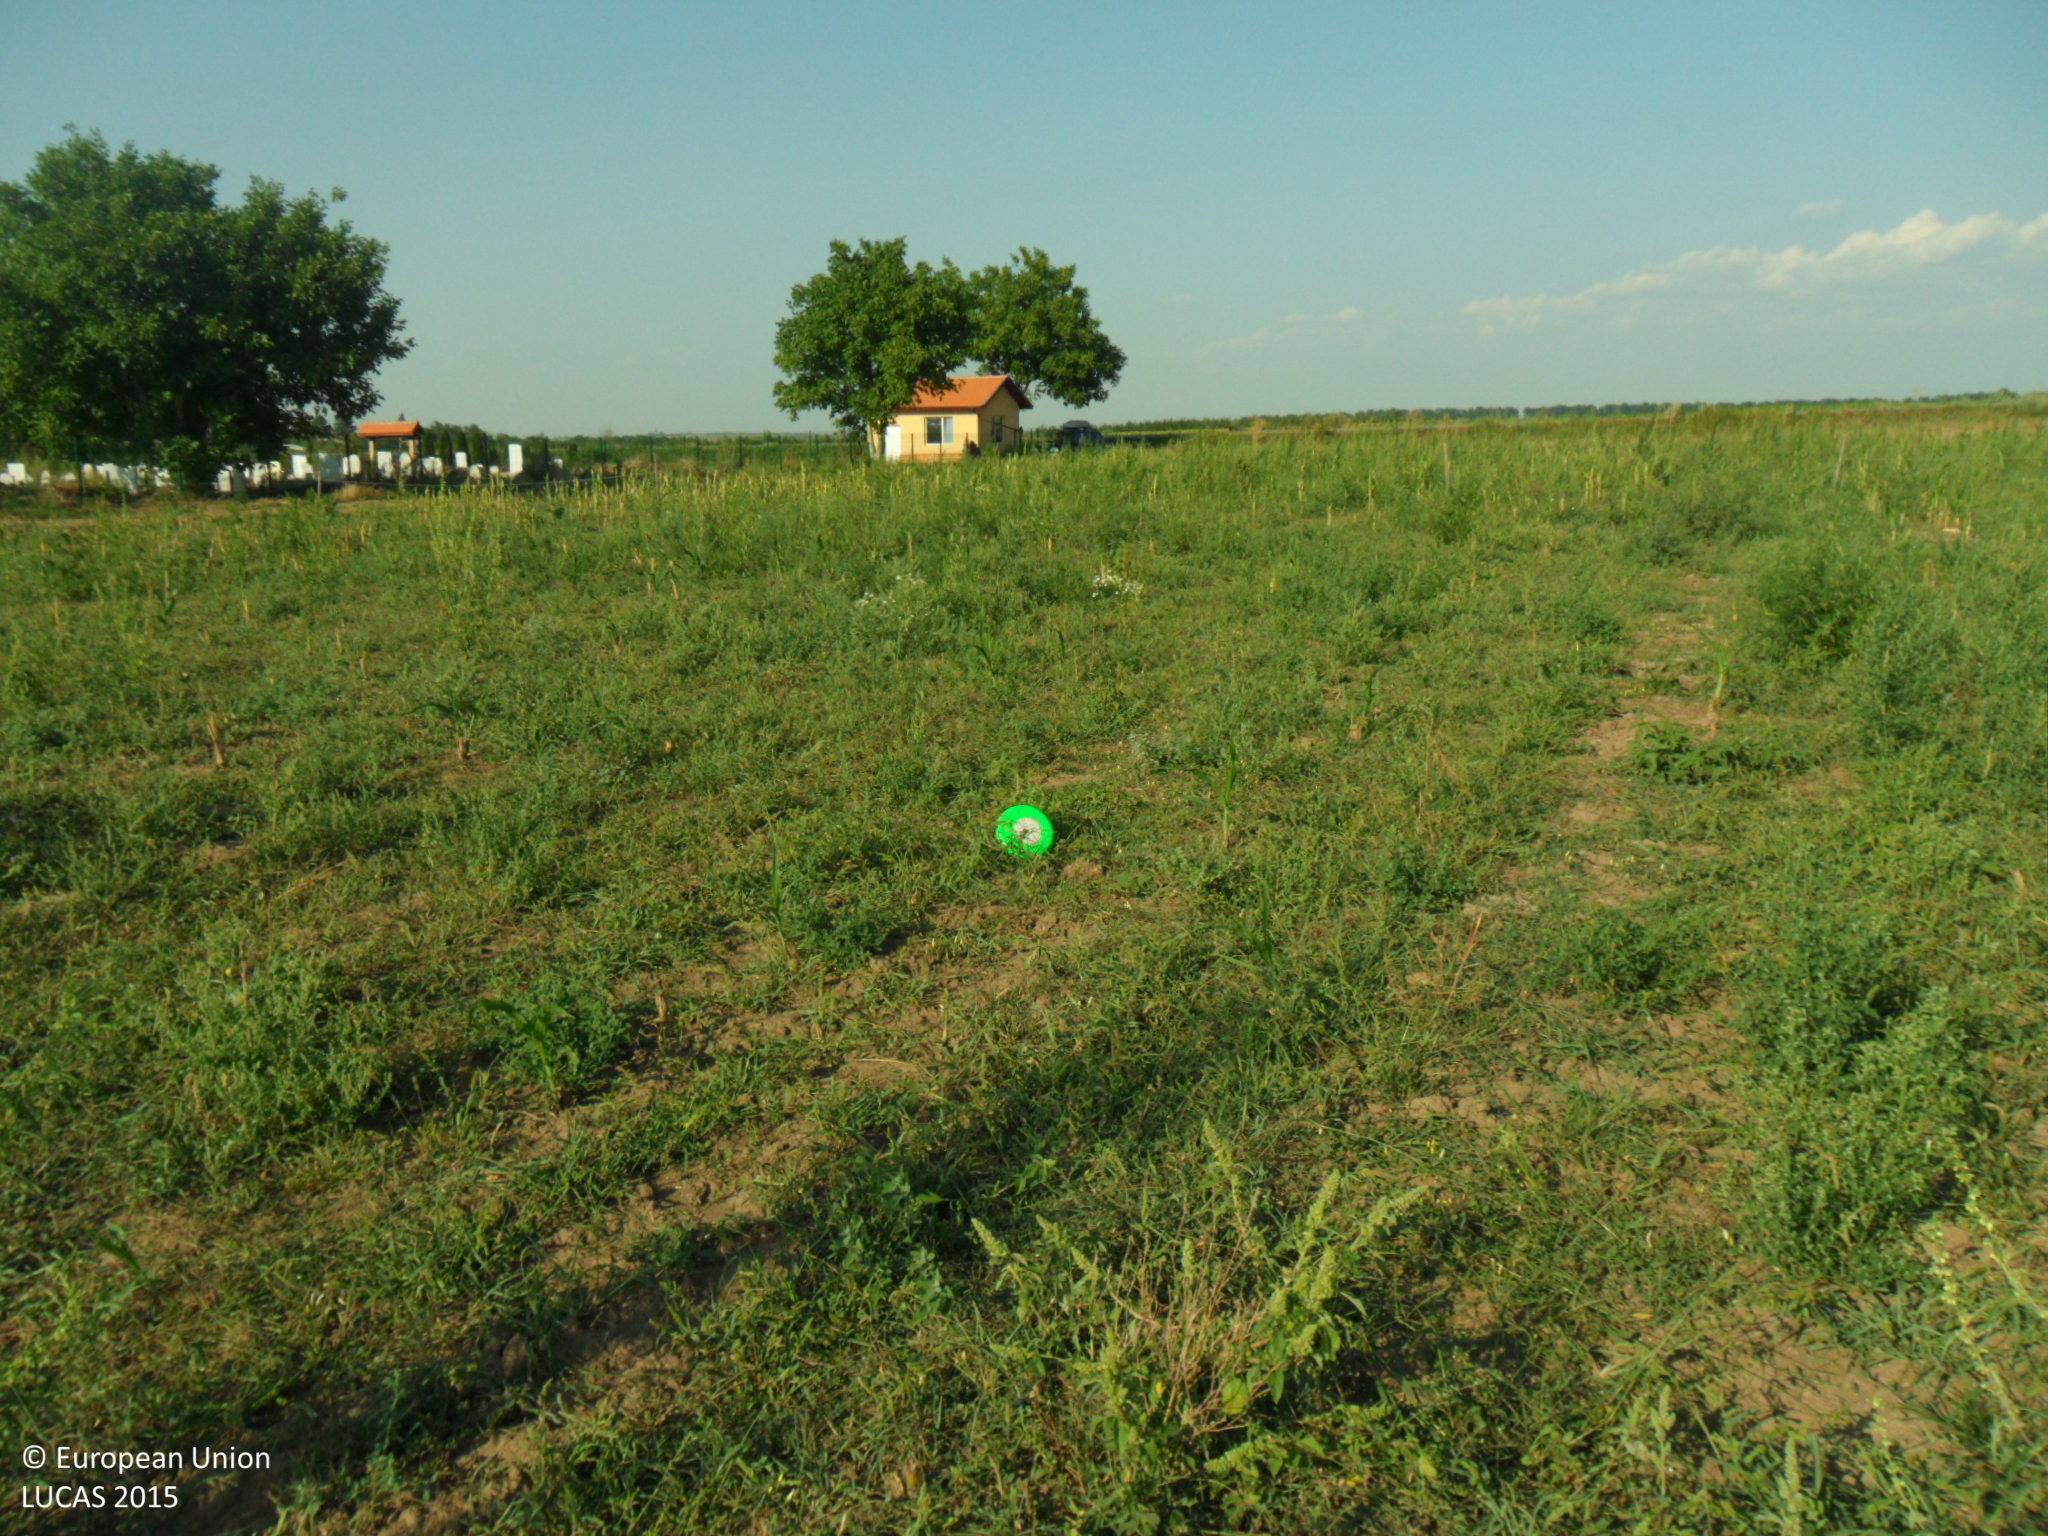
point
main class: Cropland
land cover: Maize
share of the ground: 10 - 25 %
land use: Agriculture (excluding fallow land and kitchen gardens)
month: July
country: BG
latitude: 43.6942
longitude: 27.0828
